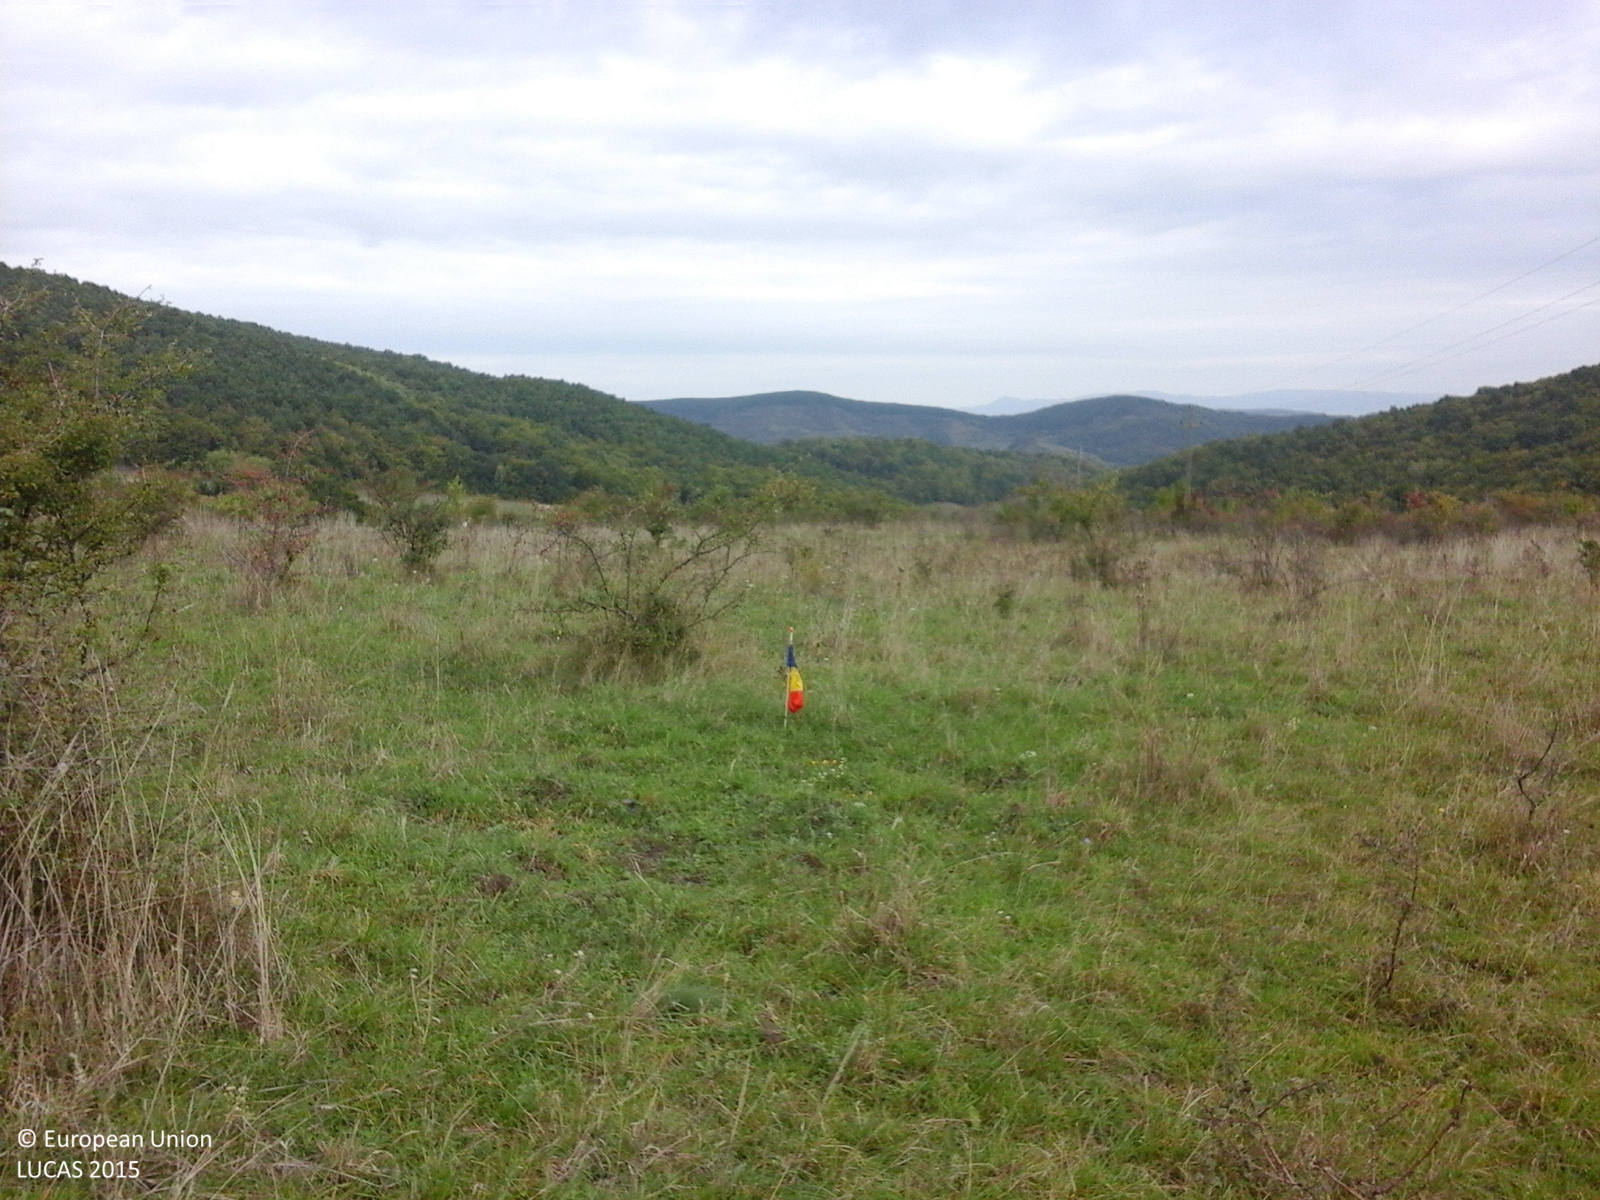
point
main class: Grassland
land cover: Grassland with sparse tree/shrub cover
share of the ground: > 75 %
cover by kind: herbaceous plants 85 %, shrubs 10 %, broadleaved forest trees 5 %
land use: Agriculture (excluding fallow land and kitchen gardens)
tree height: < 5 m
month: October
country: RO
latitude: 46.6864
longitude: 24.8038
